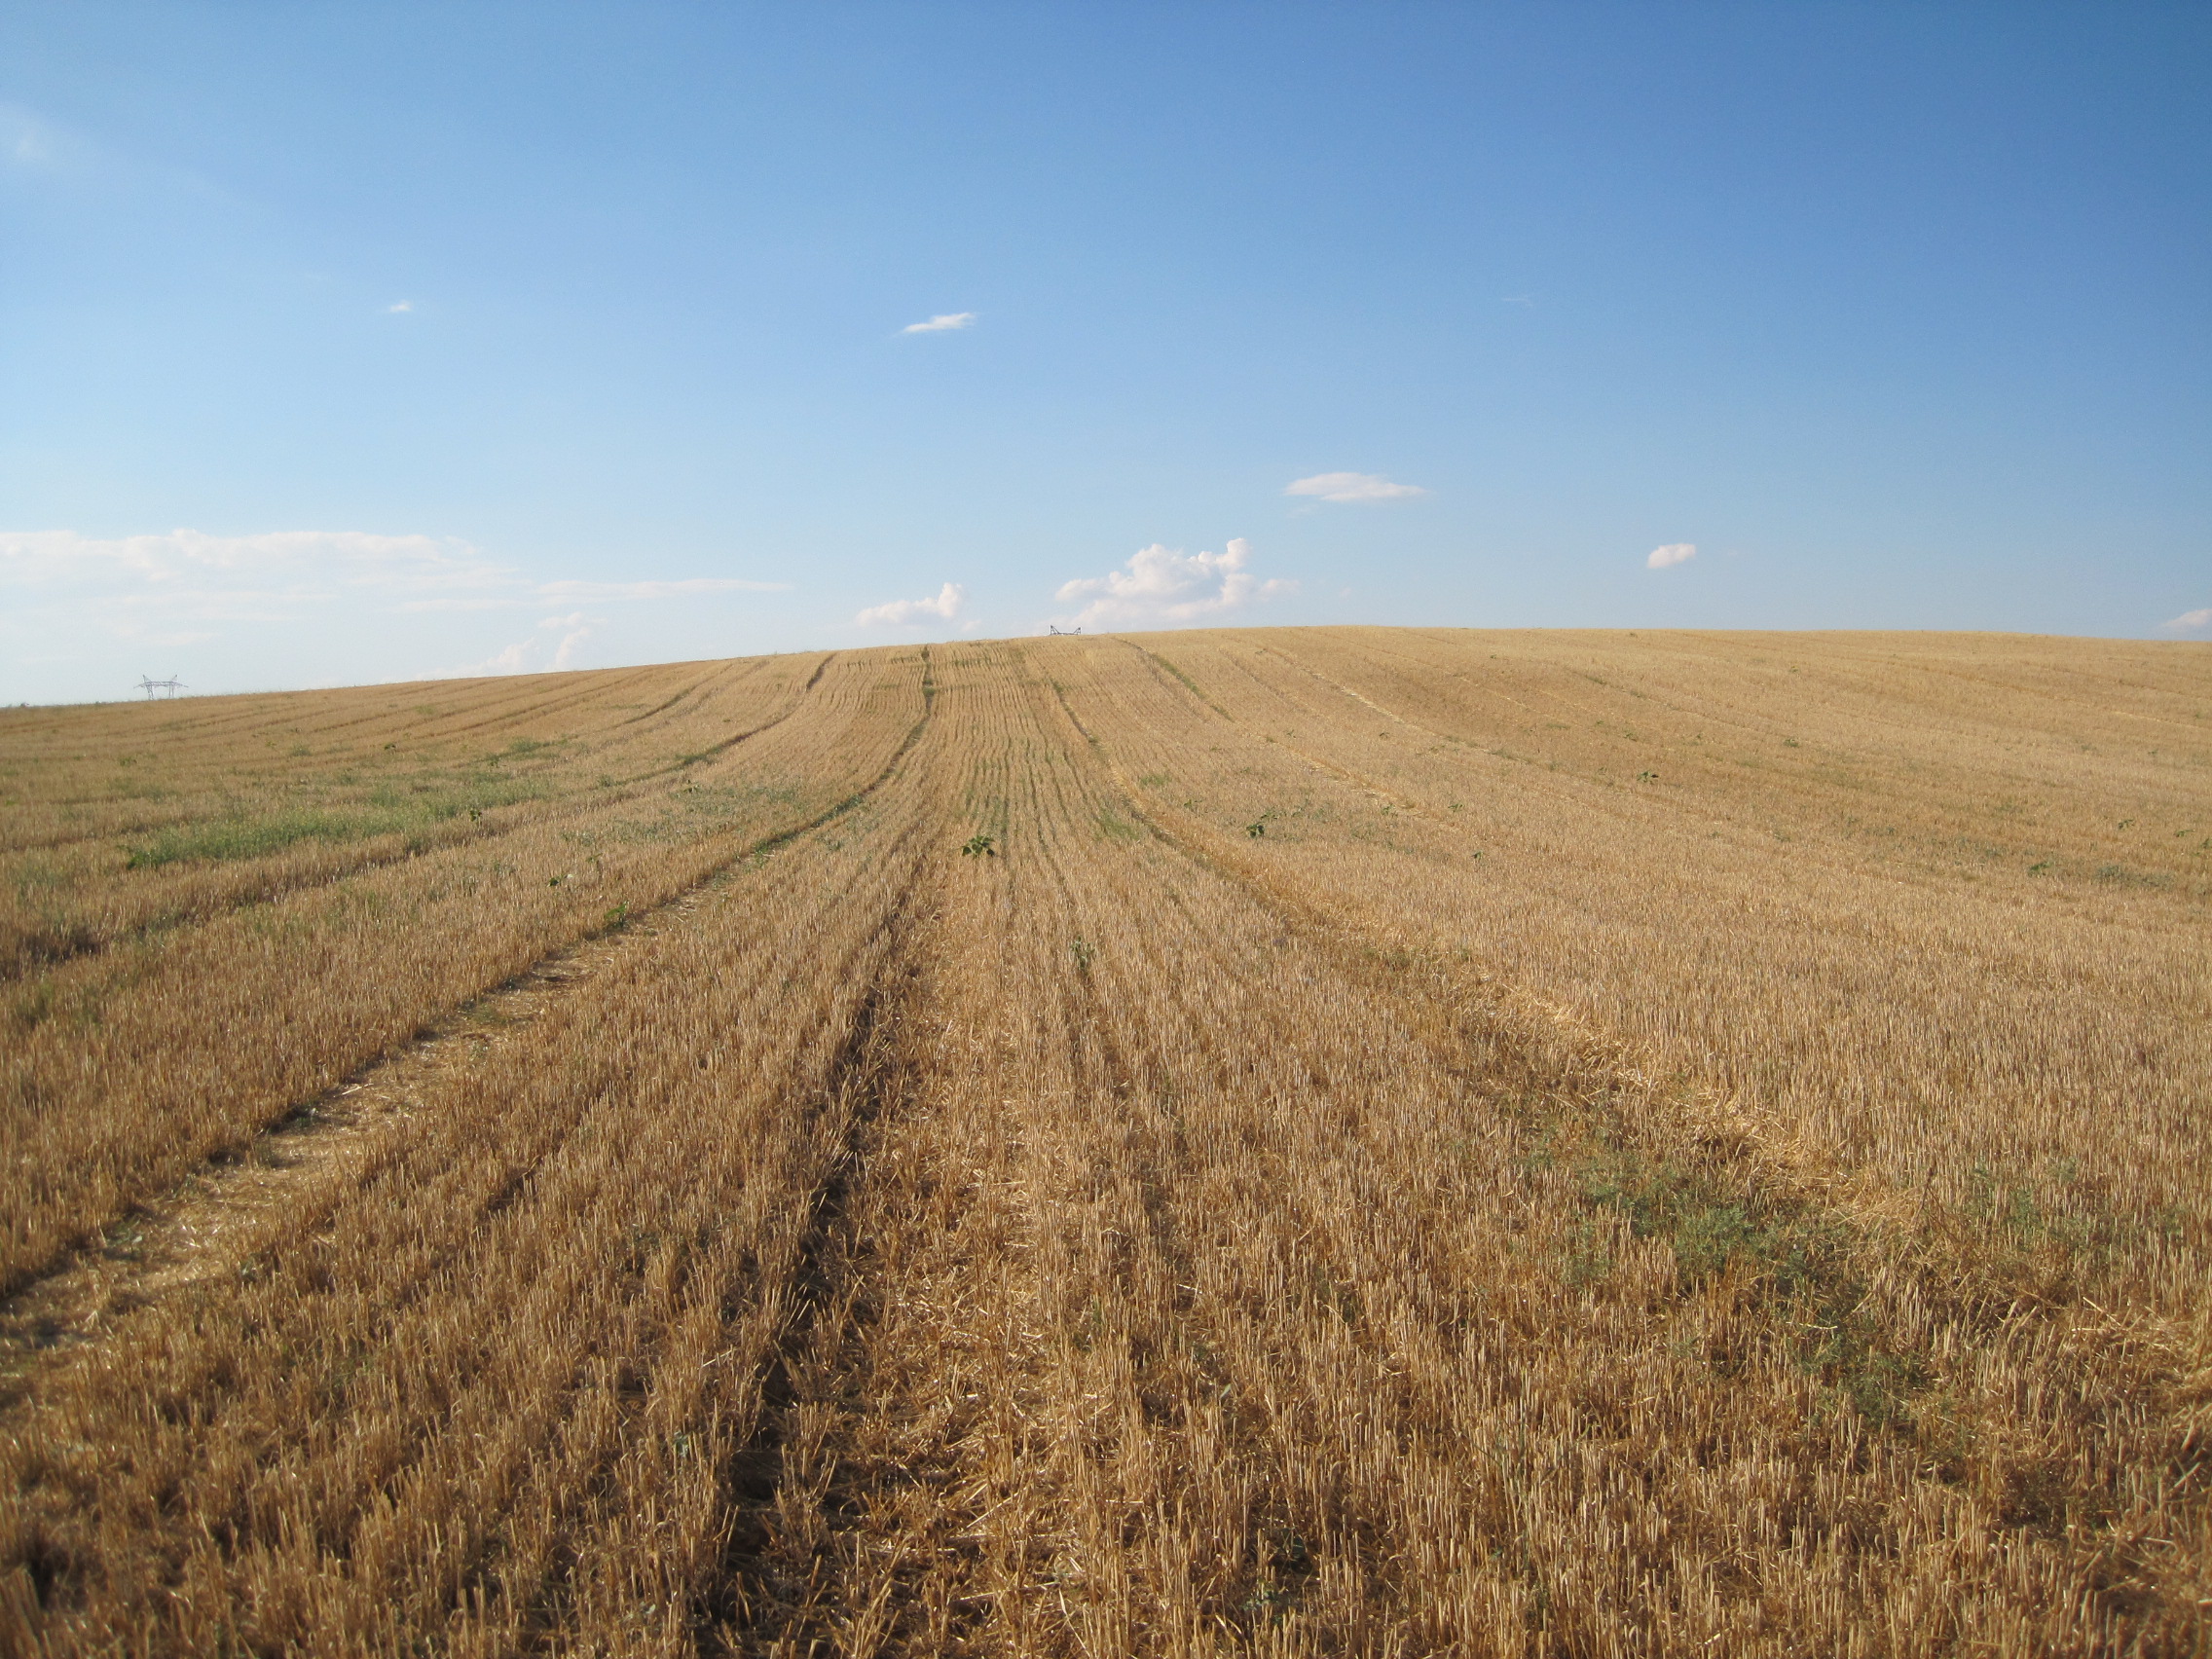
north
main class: Cropland
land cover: Barley
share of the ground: < 10 %
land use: Agriculture (excluding fallow land and kitchen gardens)
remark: Harvested field
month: July
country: ES
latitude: 41.9262
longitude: -5.1663
